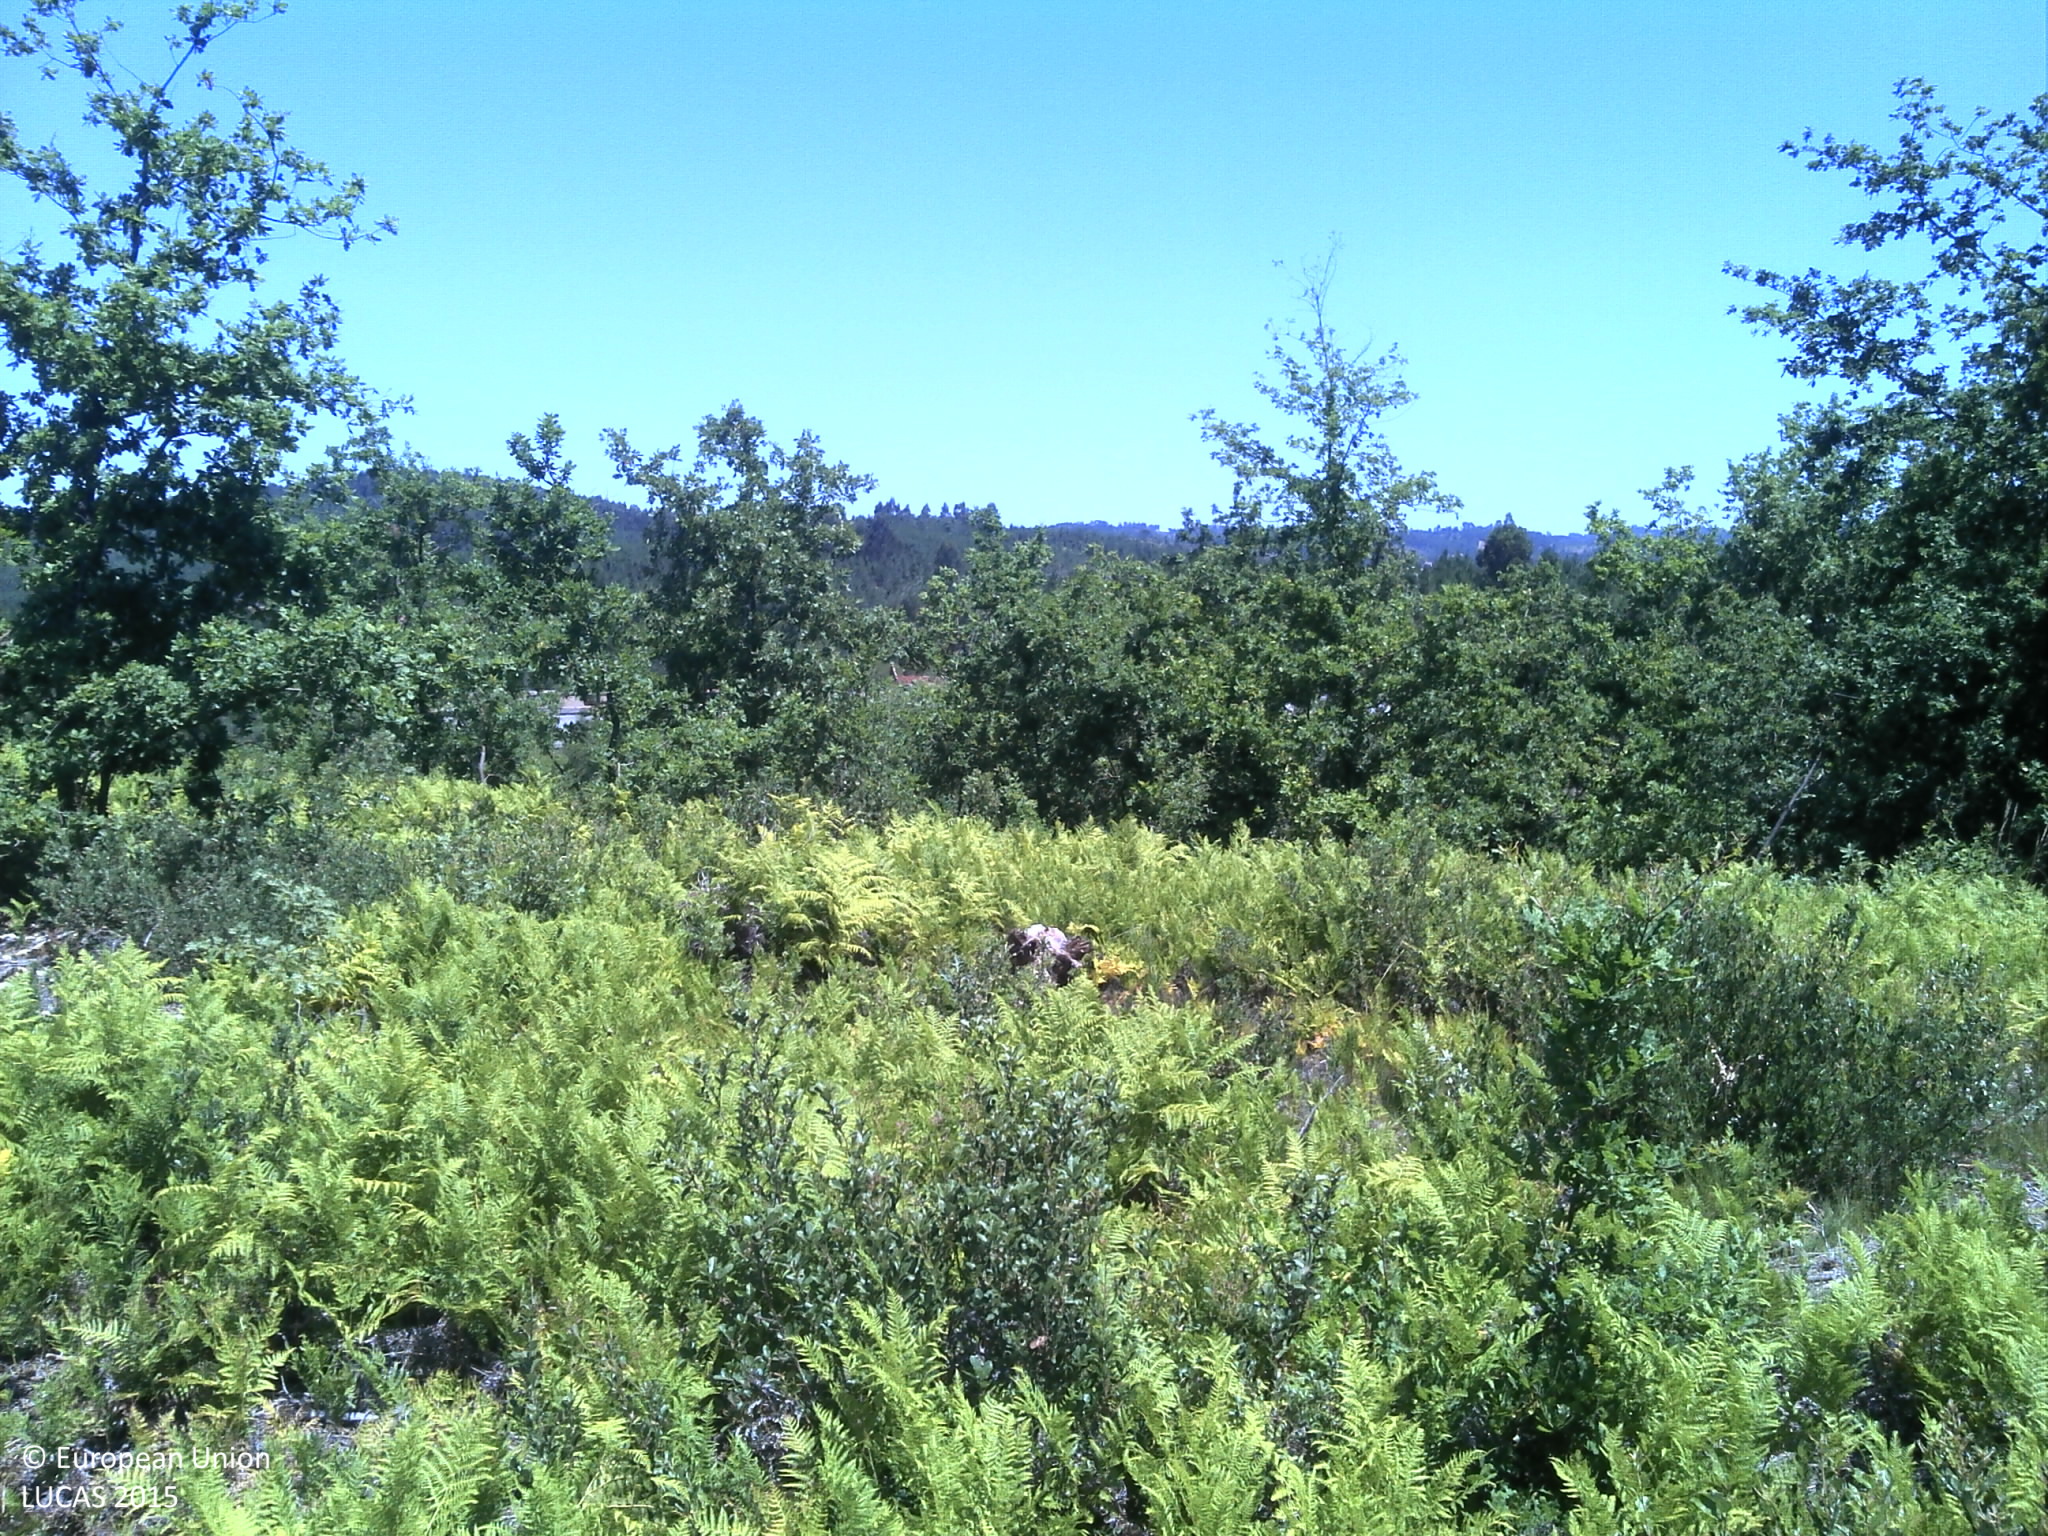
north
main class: Grassland
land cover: Grassland with sparse tree/shrub cover
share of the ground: > 75 %
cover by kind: herbaceous plants 50 %, unconsolidated bare surface 40 %, broadleaved forest trees 5 %, shrubs 5 %
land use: Forestry
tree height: < 5 m
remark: Clear cut
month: July
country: PT
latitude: 40.2717
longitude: -7.9829
